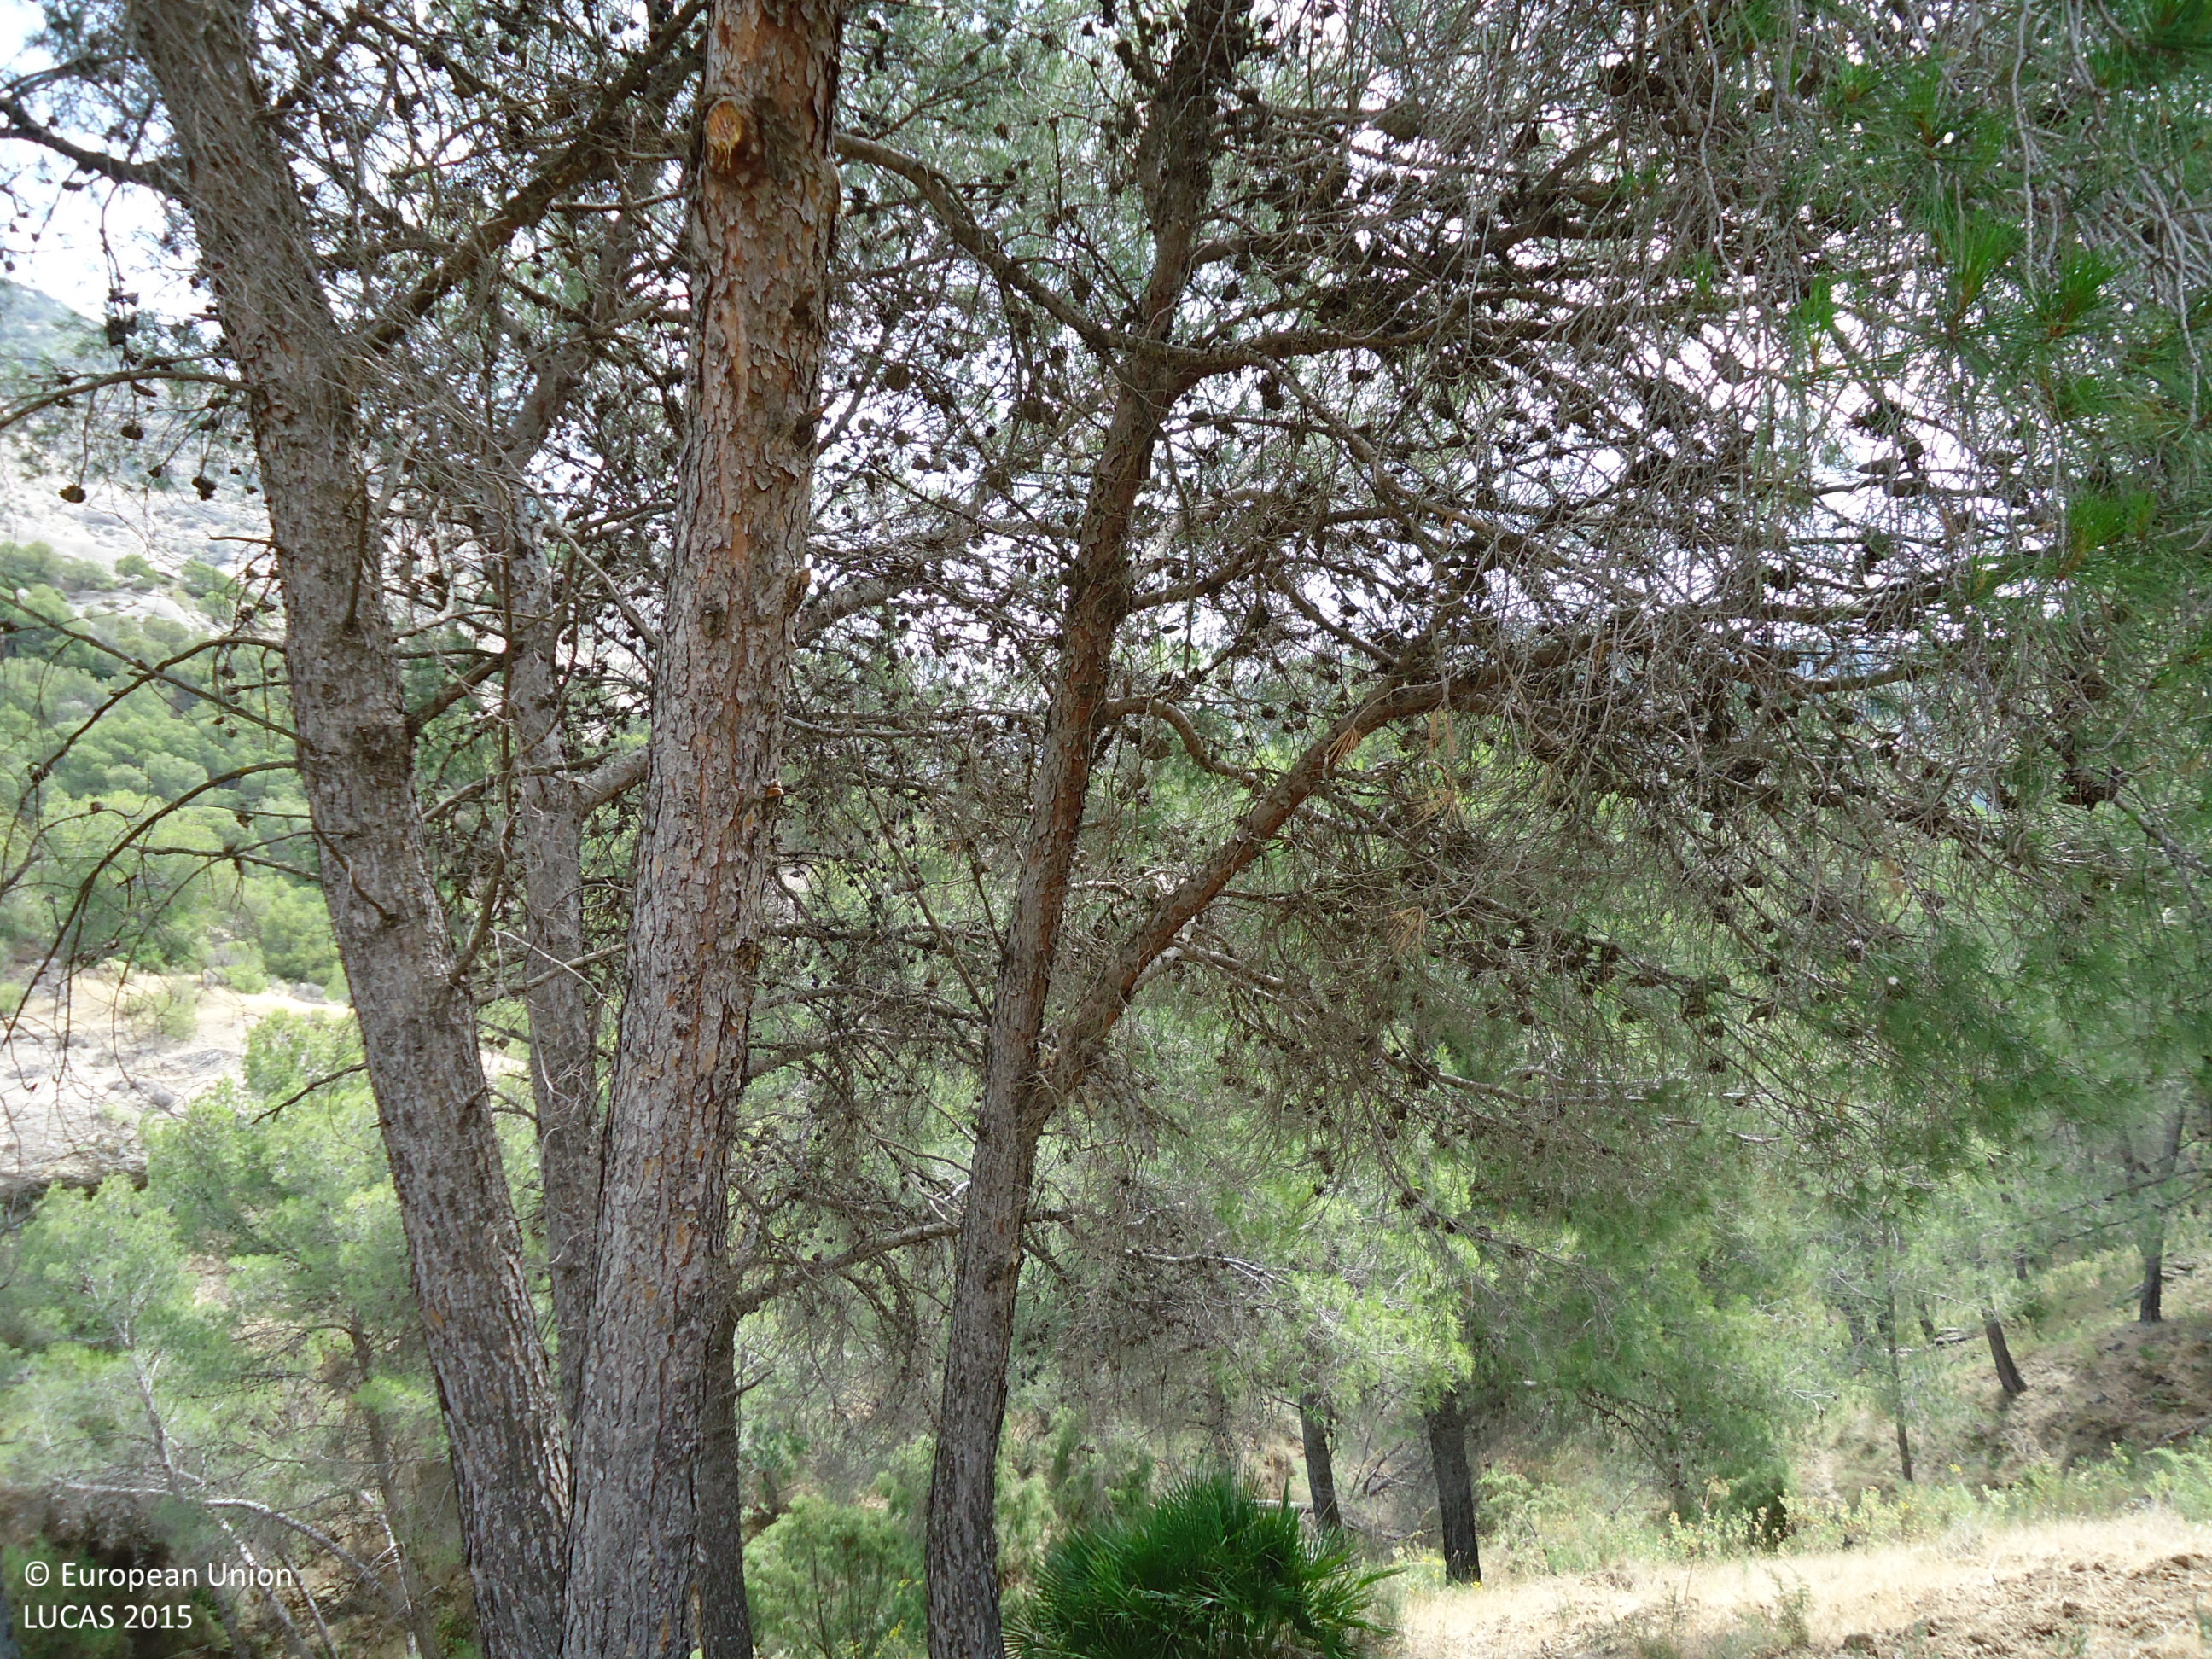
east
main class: Woodland
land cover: Pine dominated coniferous woodland
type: coniferous forest of the mediterranean region
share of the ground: > 75 %
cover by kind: coniferous forest trees 75 %, consolidated bare surface 20 %, shrubs 5 %
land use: Forestry
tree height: > 5 m
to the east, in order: Pine dominated coniferous woodland
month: June
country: ES
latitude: 36.9134
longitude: -4.8026
